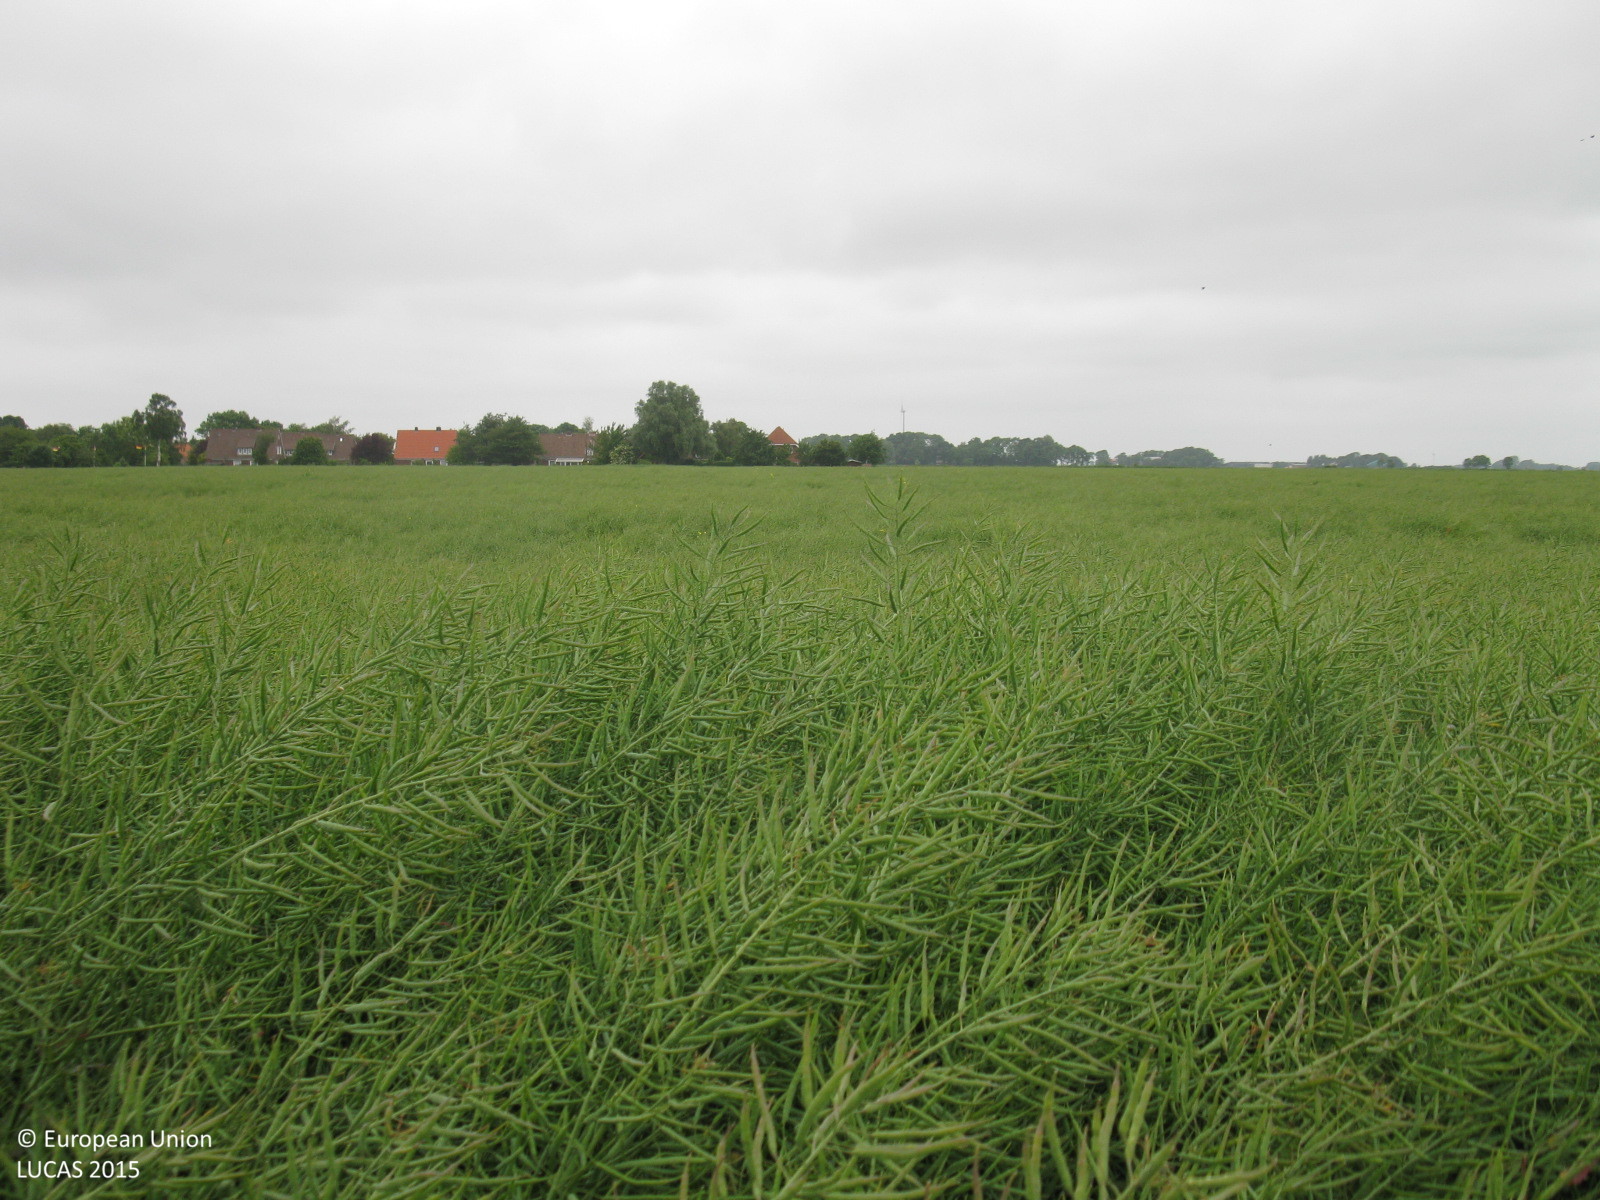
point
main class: Cropland
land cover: Rape and turnip rape
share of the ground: > 75 %
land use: Agriculture (excluding fallow land and kitchen gardens)
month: June
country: DE
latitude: 53.6708
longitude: 7.8665
